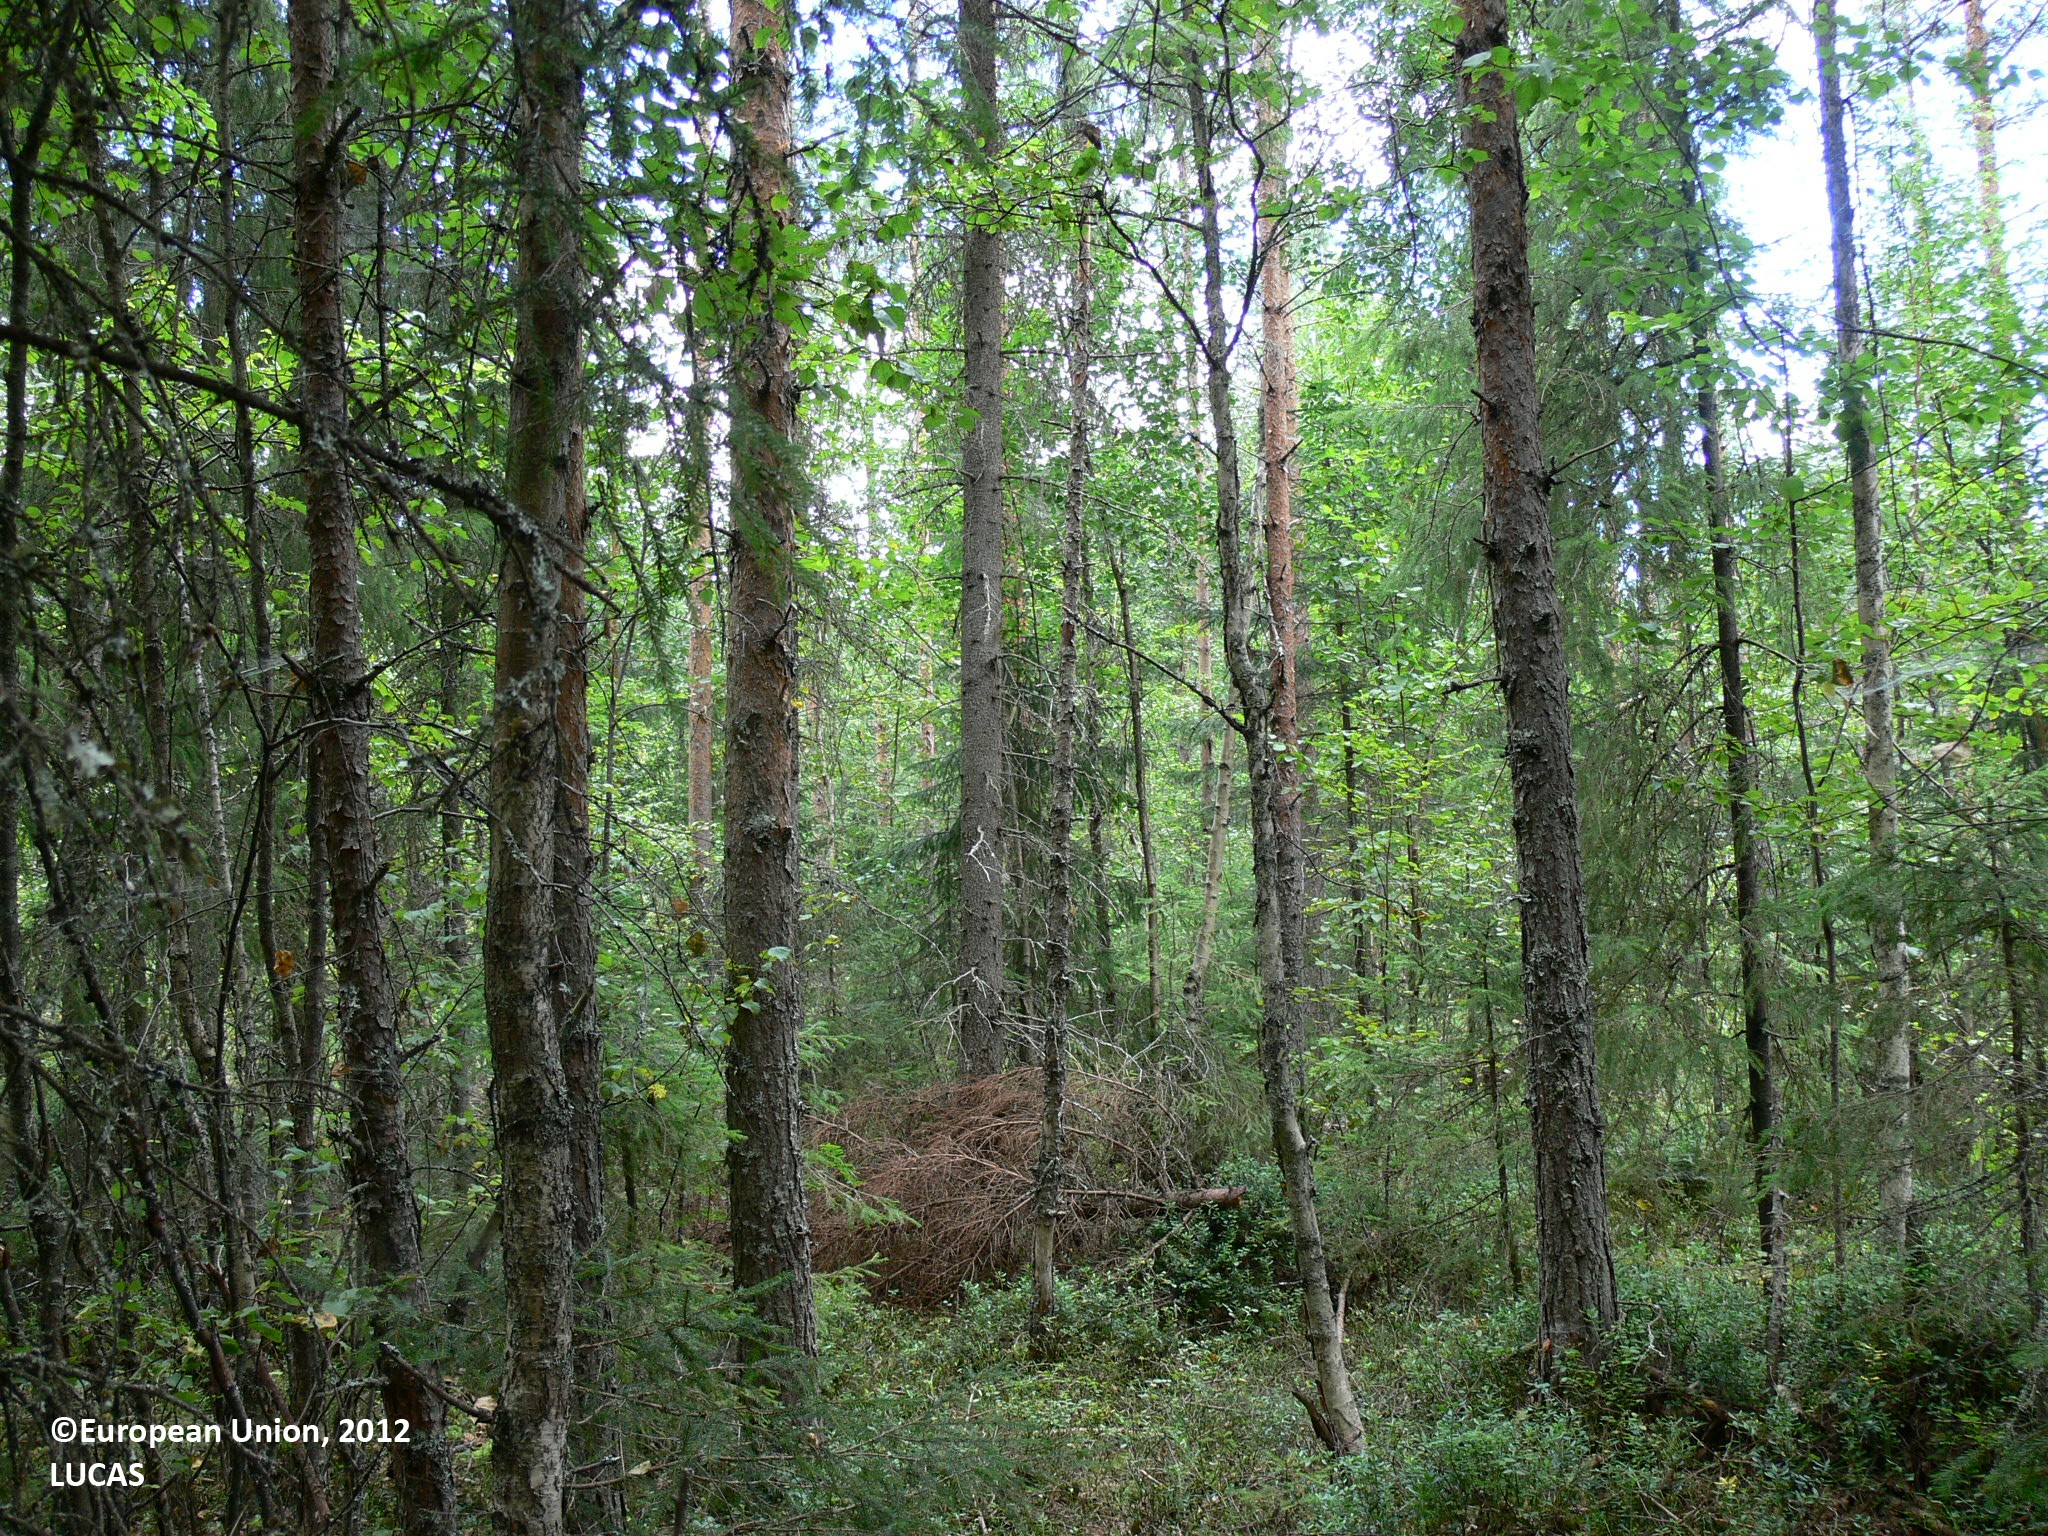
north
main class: Woodland
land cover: Other coniferous woodland
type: boreal forest
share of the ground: > 75 %
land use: Forestry
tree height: > 5 m
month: August
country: FI
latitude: 62.0420
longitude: 29.3791
